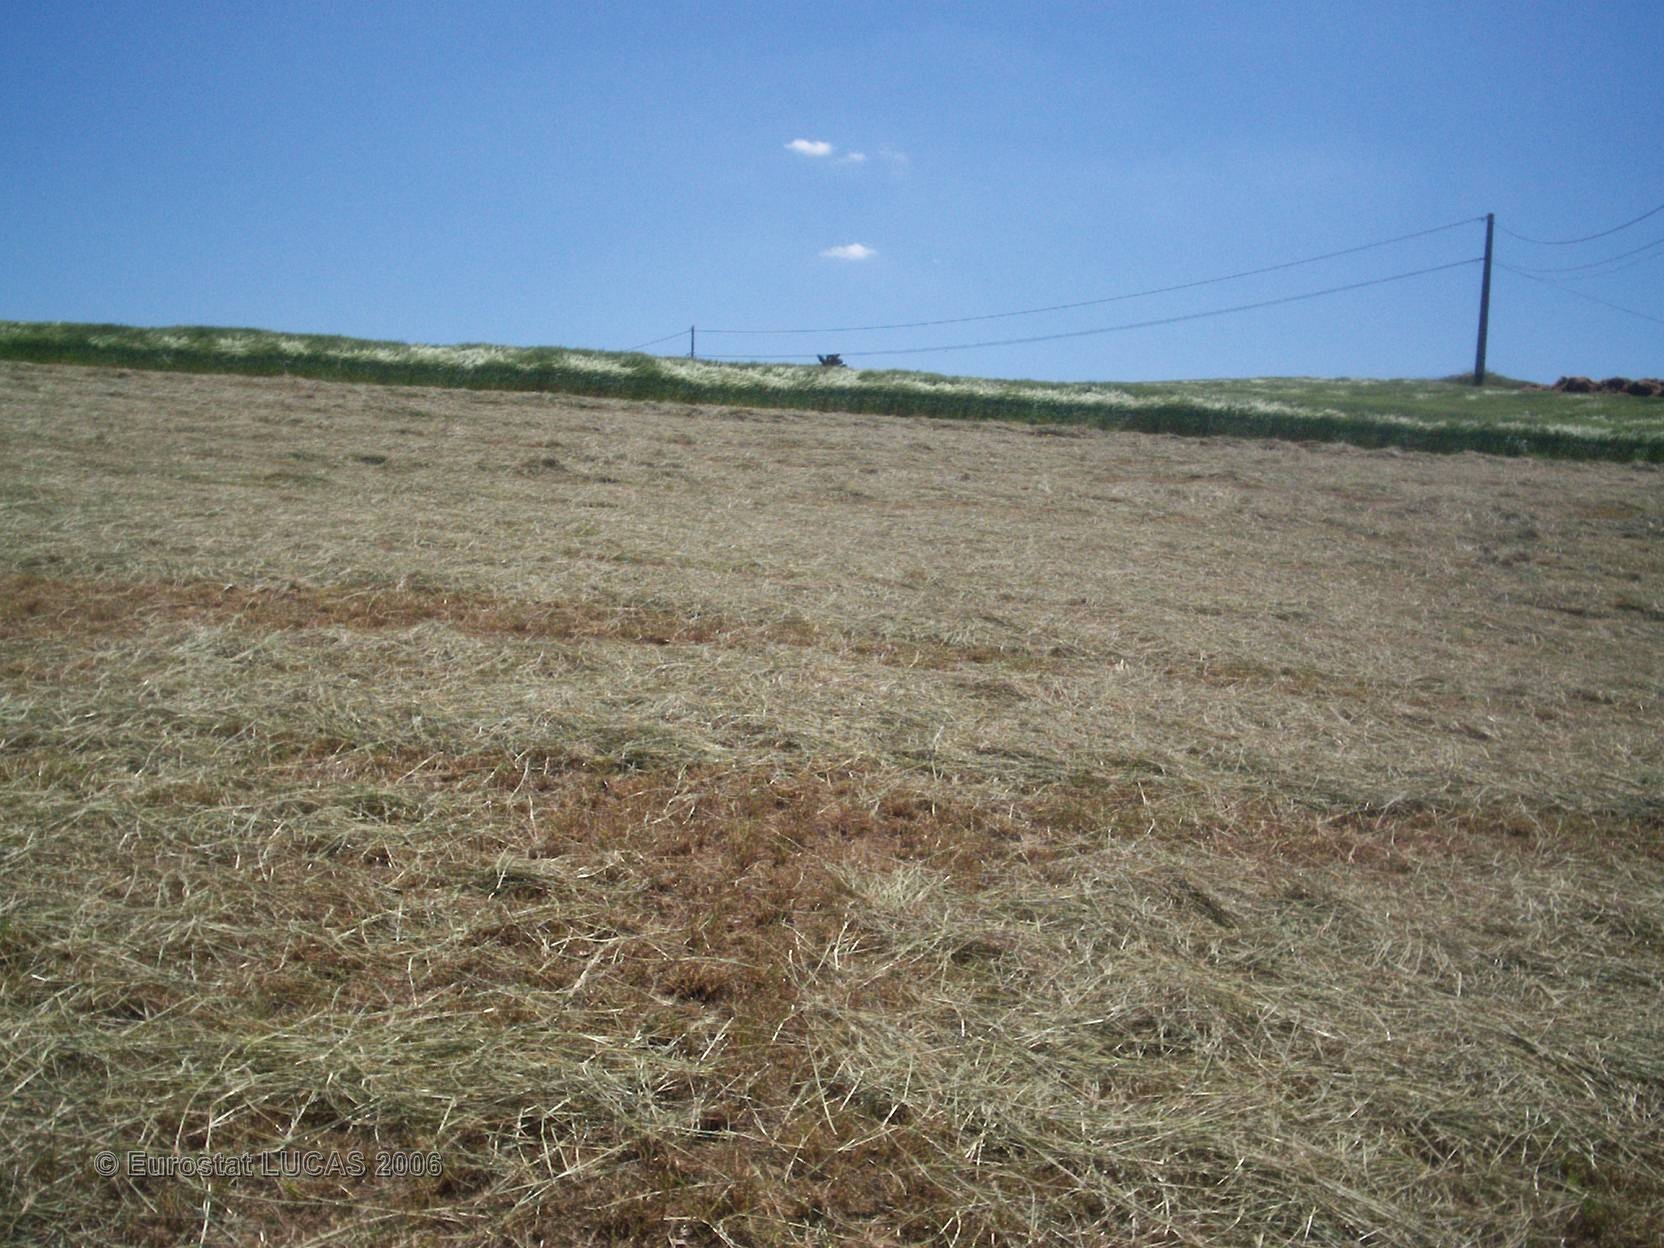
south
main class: Cropland
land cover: Durum wheat
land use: Agriculture (excluding fallow land and kitchen gardens)
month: May
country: FR
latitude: 45.0506
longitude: 4.7868
